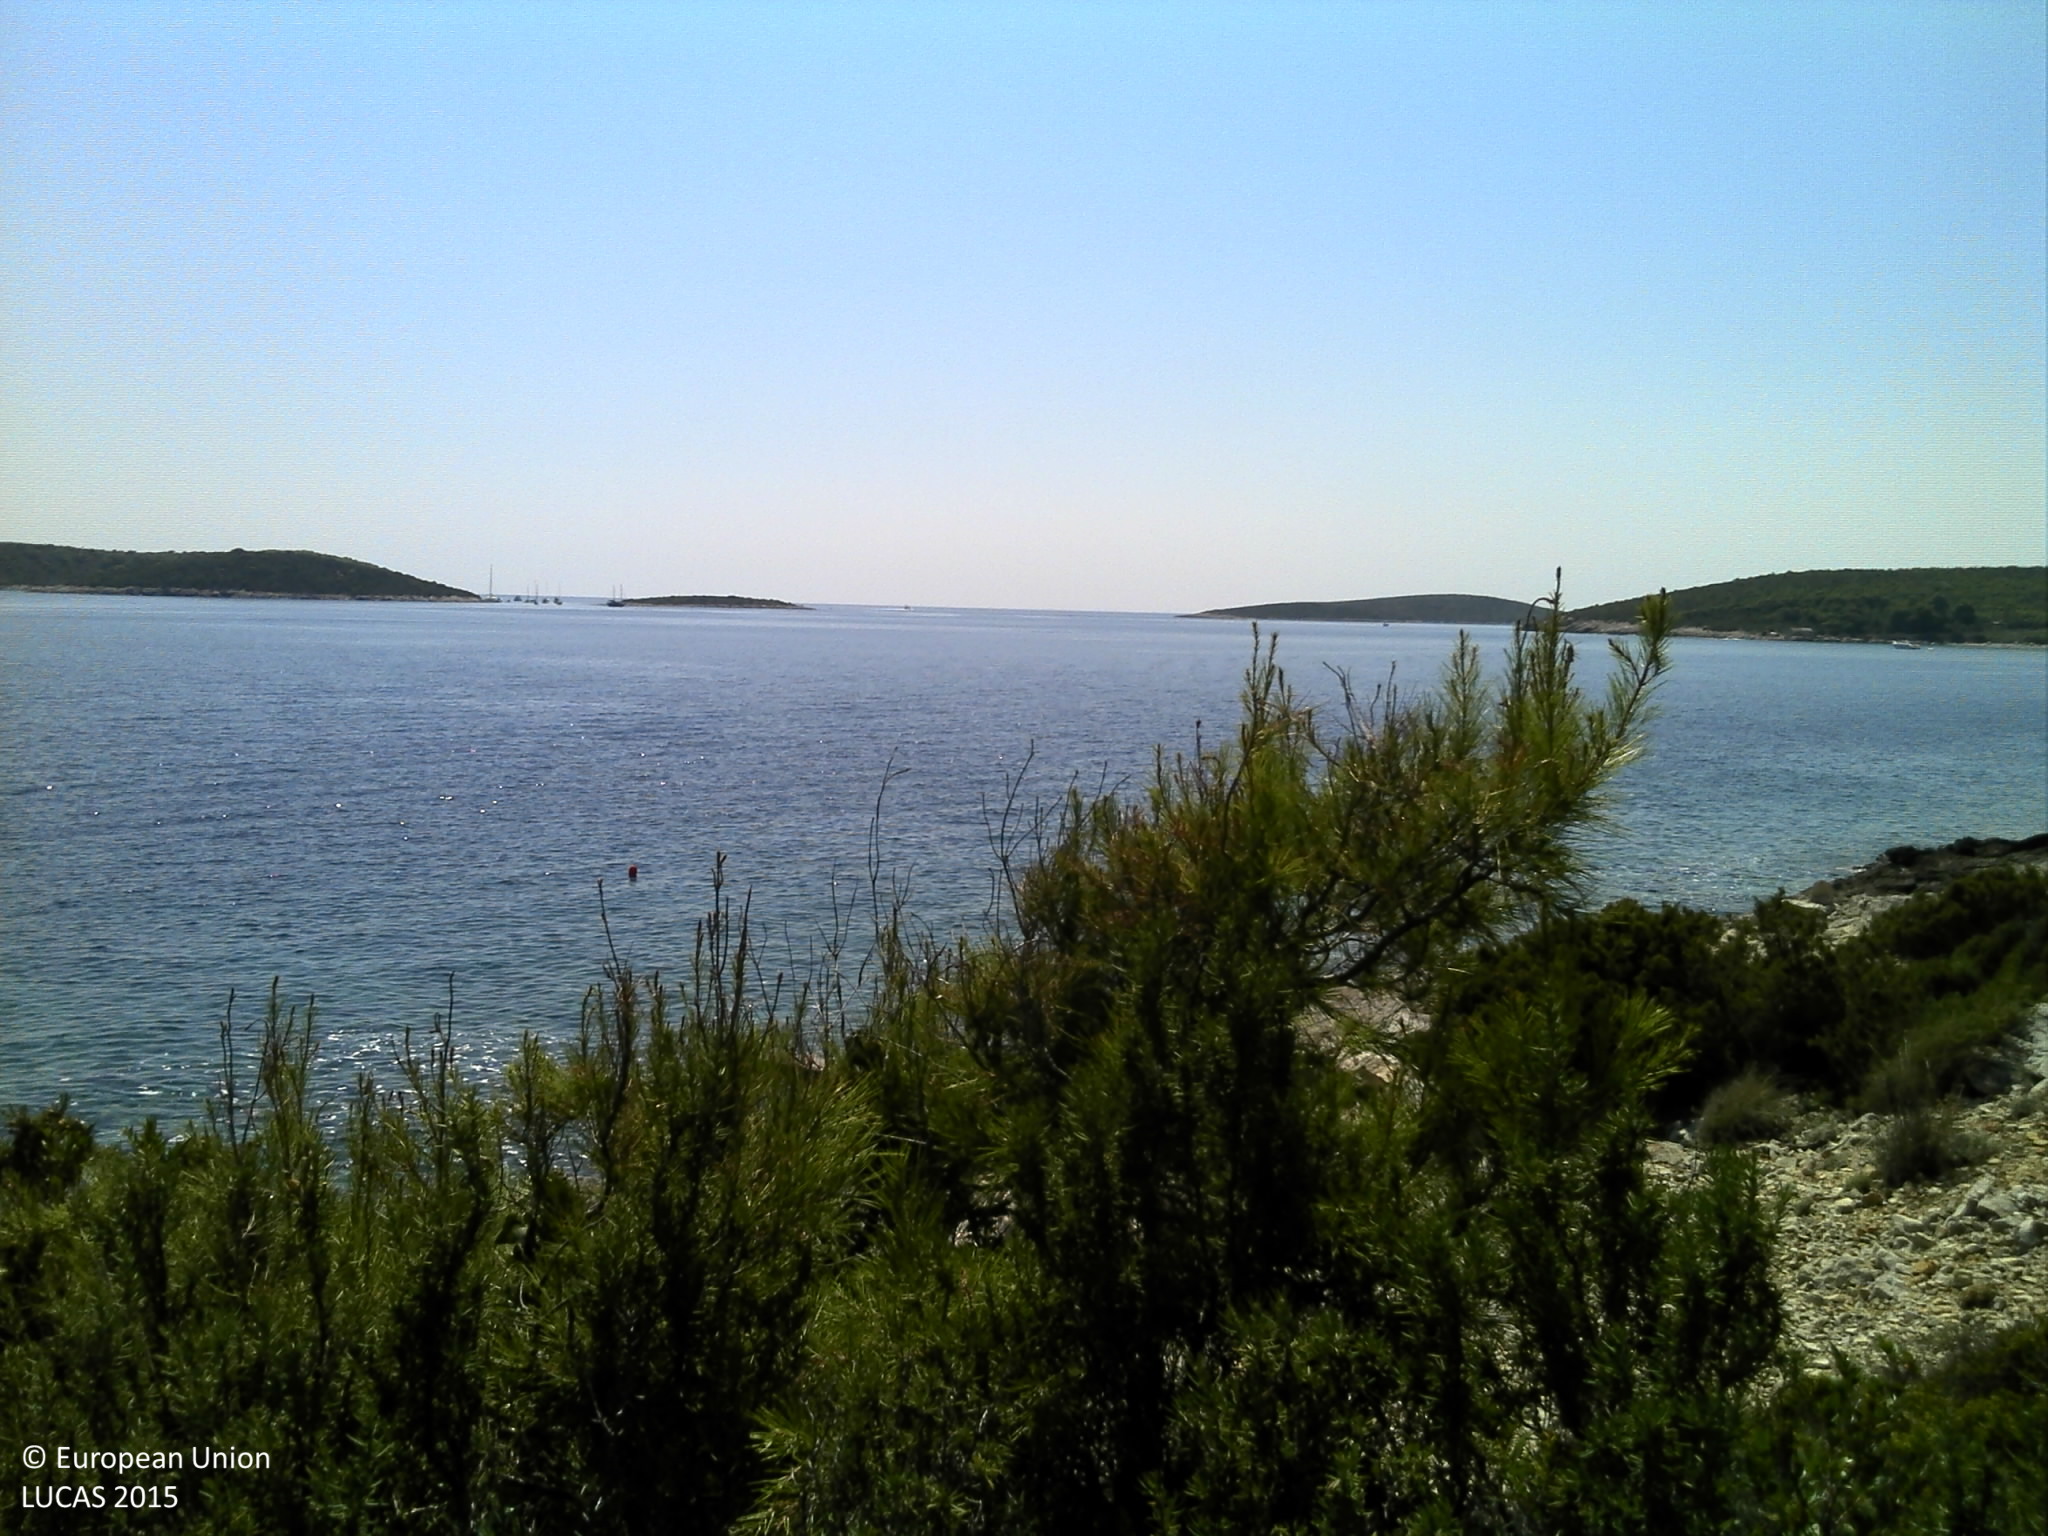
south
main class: Shrubland
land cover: Shrubland with sparse tree cover
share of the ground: > 75 %
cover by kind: shrubs 70 %, unconsolidated bare surface 15 %, coniferous forest trees 5 %, herbaceous plants 5 %, consolidated bare surface 5 %
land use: Semi-natural and natural areas not in use
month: August
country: HR
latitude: 43.0411
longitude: 16.2365
